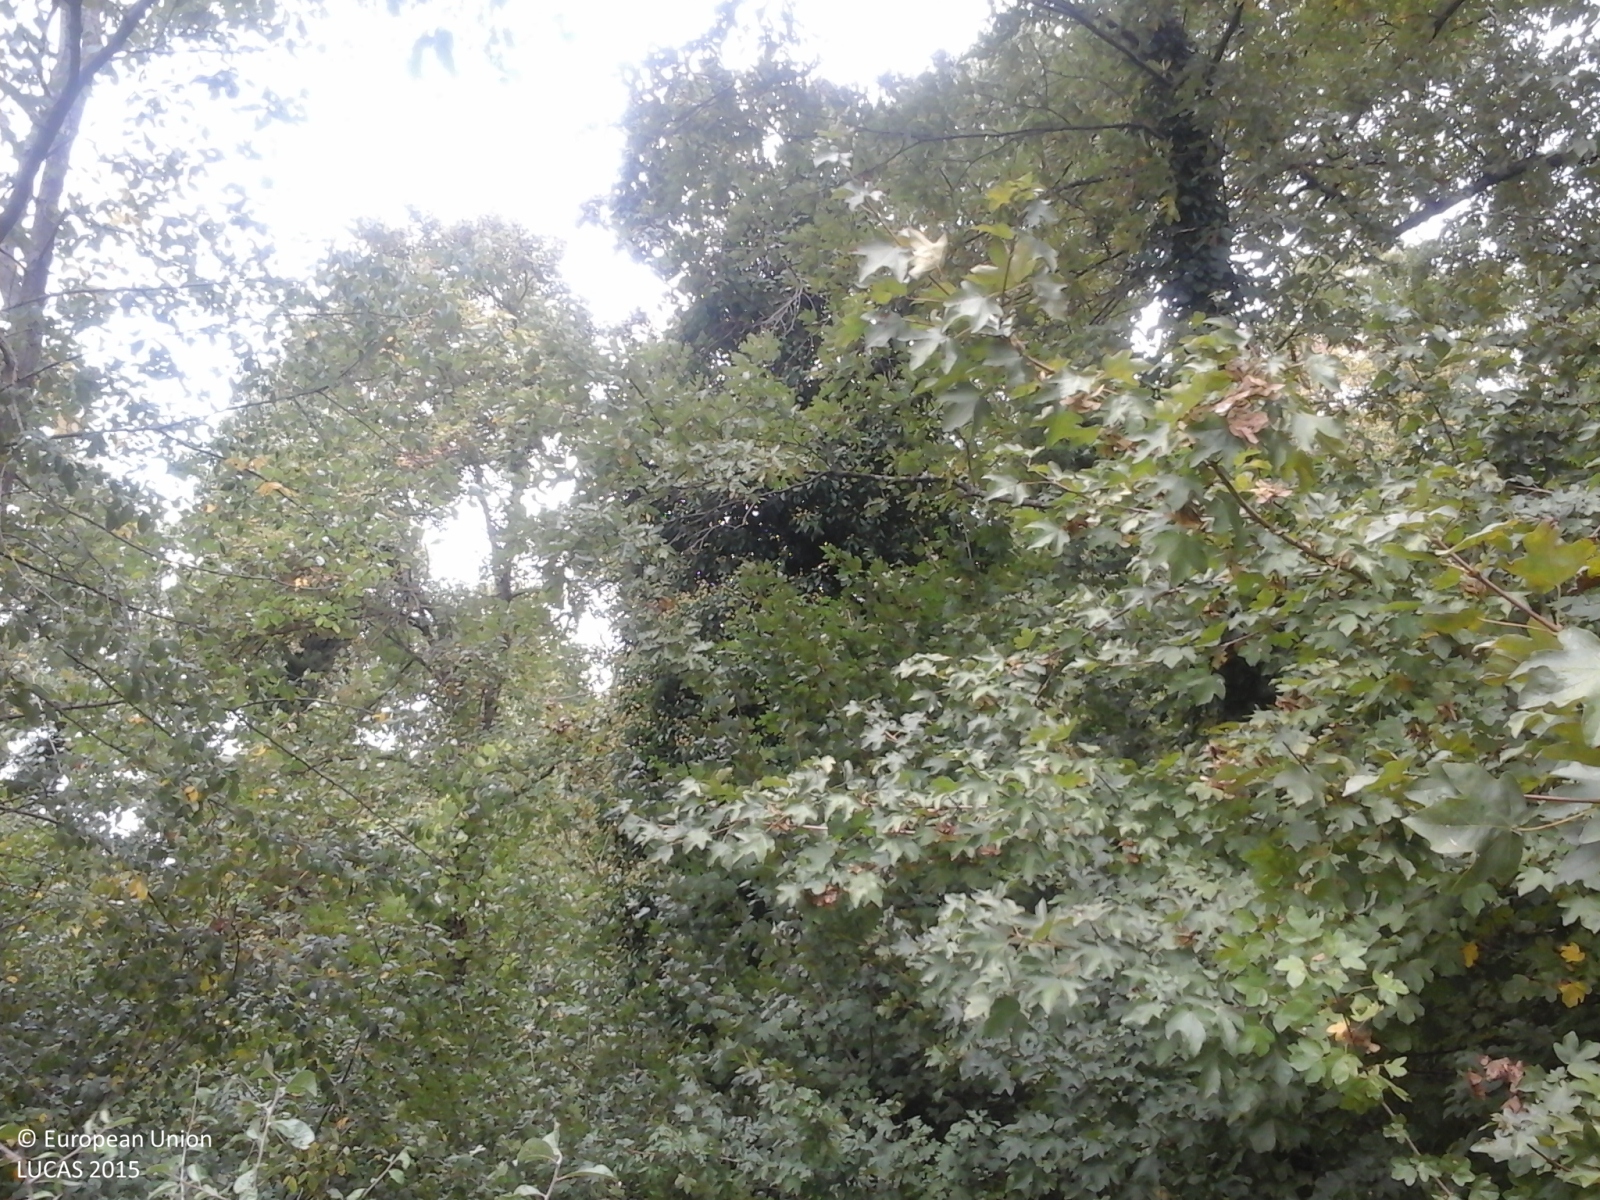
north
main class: Woodland
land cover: Broadleaved woodland
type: thermophilous deciduous forest
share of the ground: > 75 %
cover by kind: broadleaved forest trees 90 %, shrubs 10 %
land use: Forestry
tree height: > 5 m
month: October
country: IT
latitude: 43.4051
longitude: 12.2782
